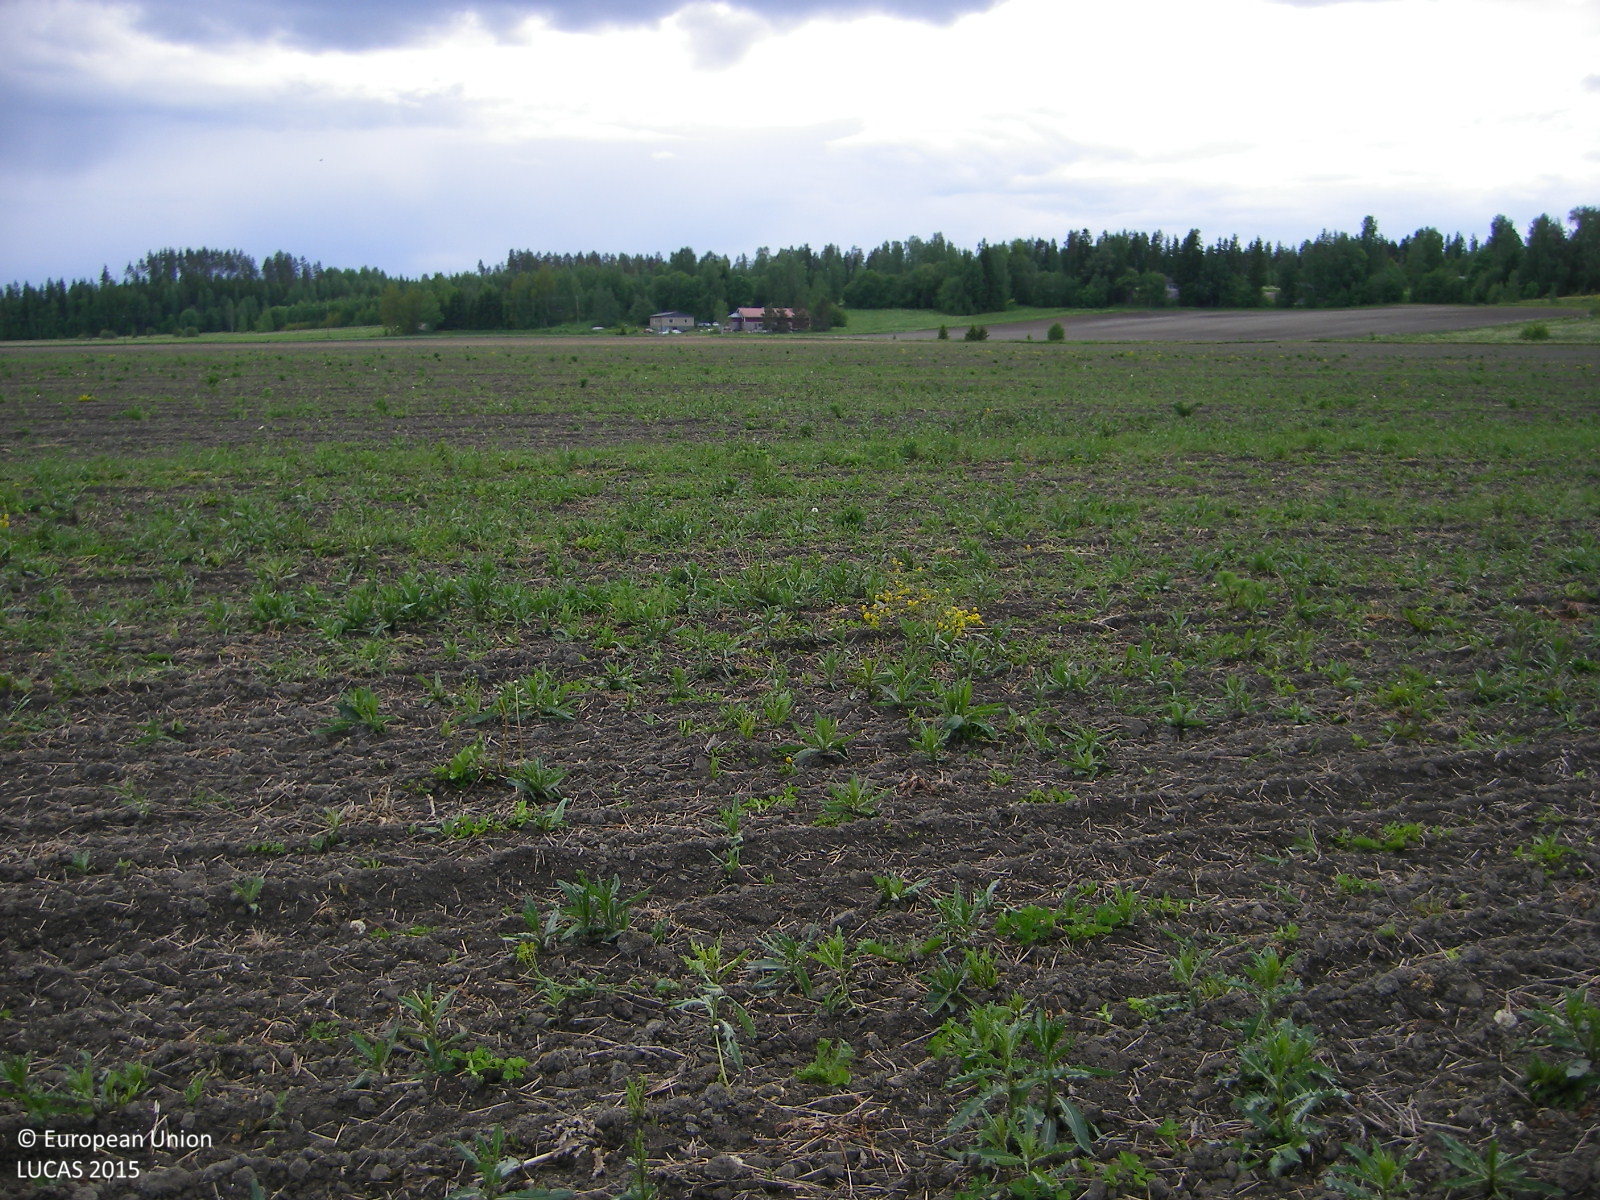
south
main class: Cropland
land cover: Common wheat
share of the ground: 10 - 25 %
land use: Agriculture (excluding fallow land and kitchen gardens)
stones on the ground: < 10 %
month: June
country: FI
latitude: 60.4226
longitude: 24.6211
